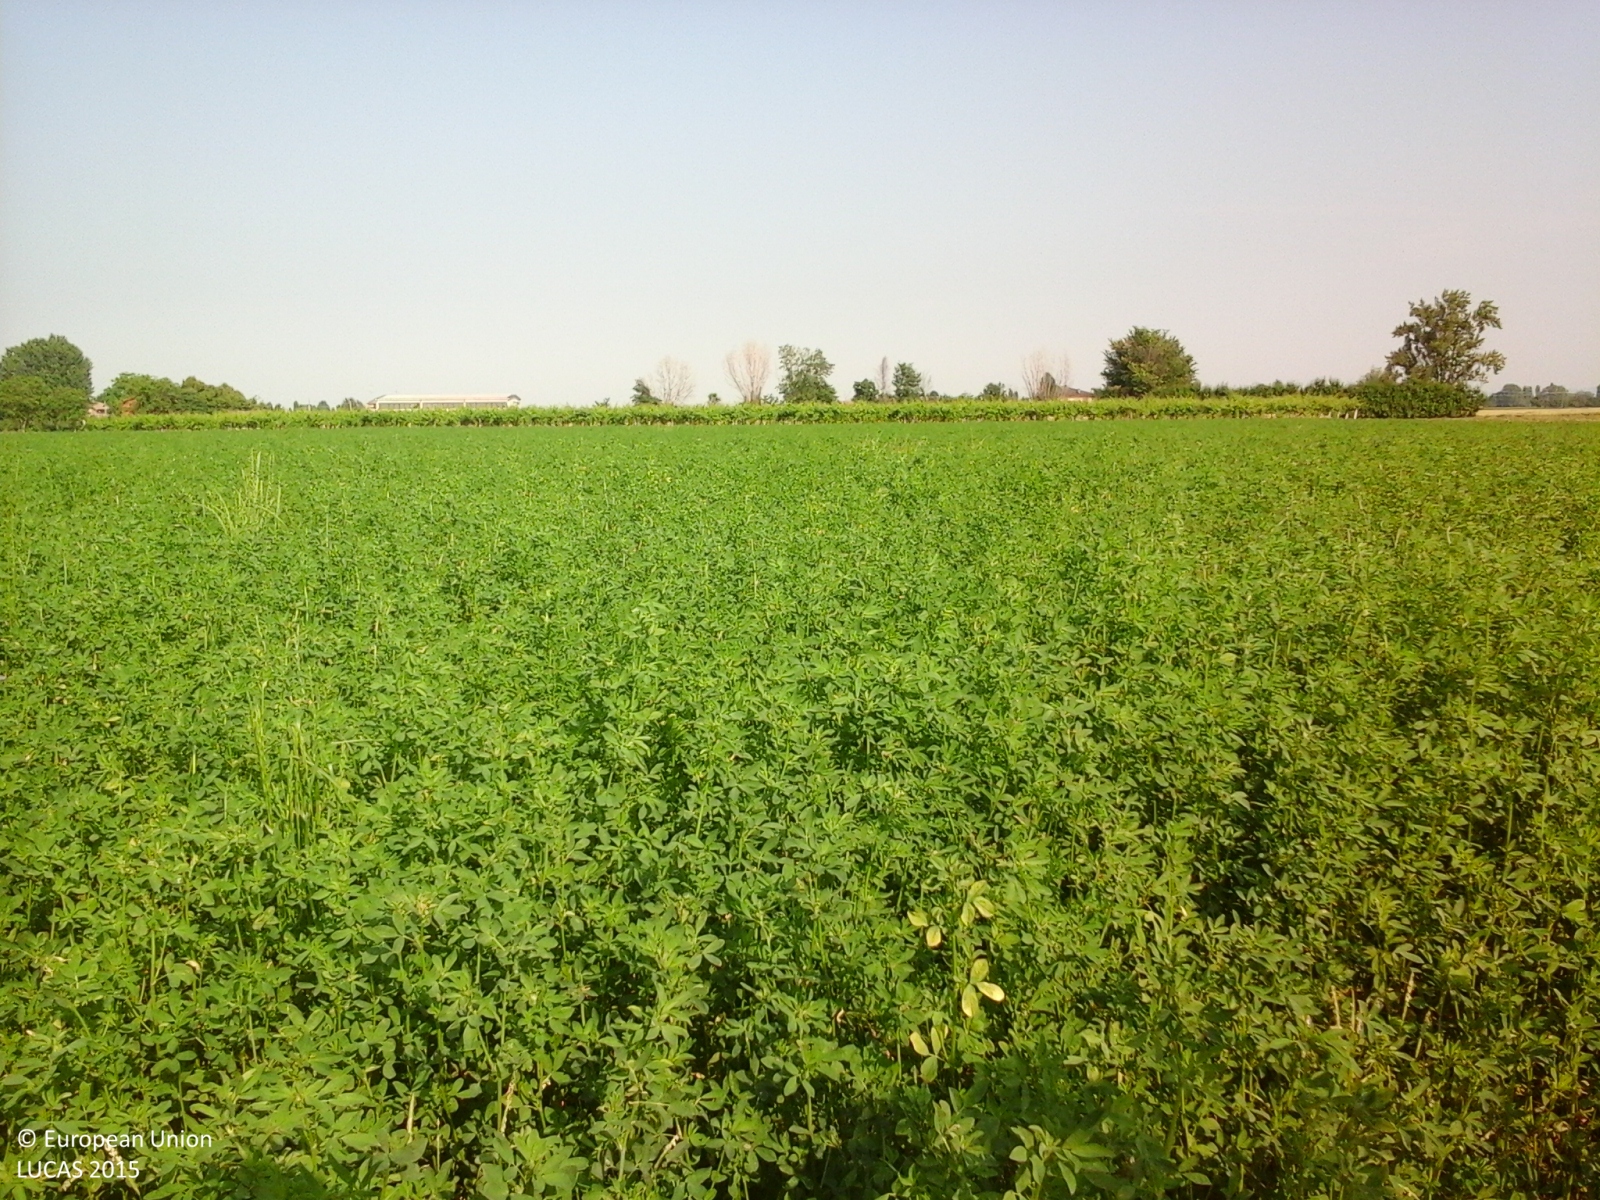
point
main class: Cropland
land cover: Lucerne
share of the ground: > 75 %
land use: Agriculture (excluding fallow land and kitchen gardens)
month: June
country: IT
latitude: 44.6145
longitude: 11.1695
